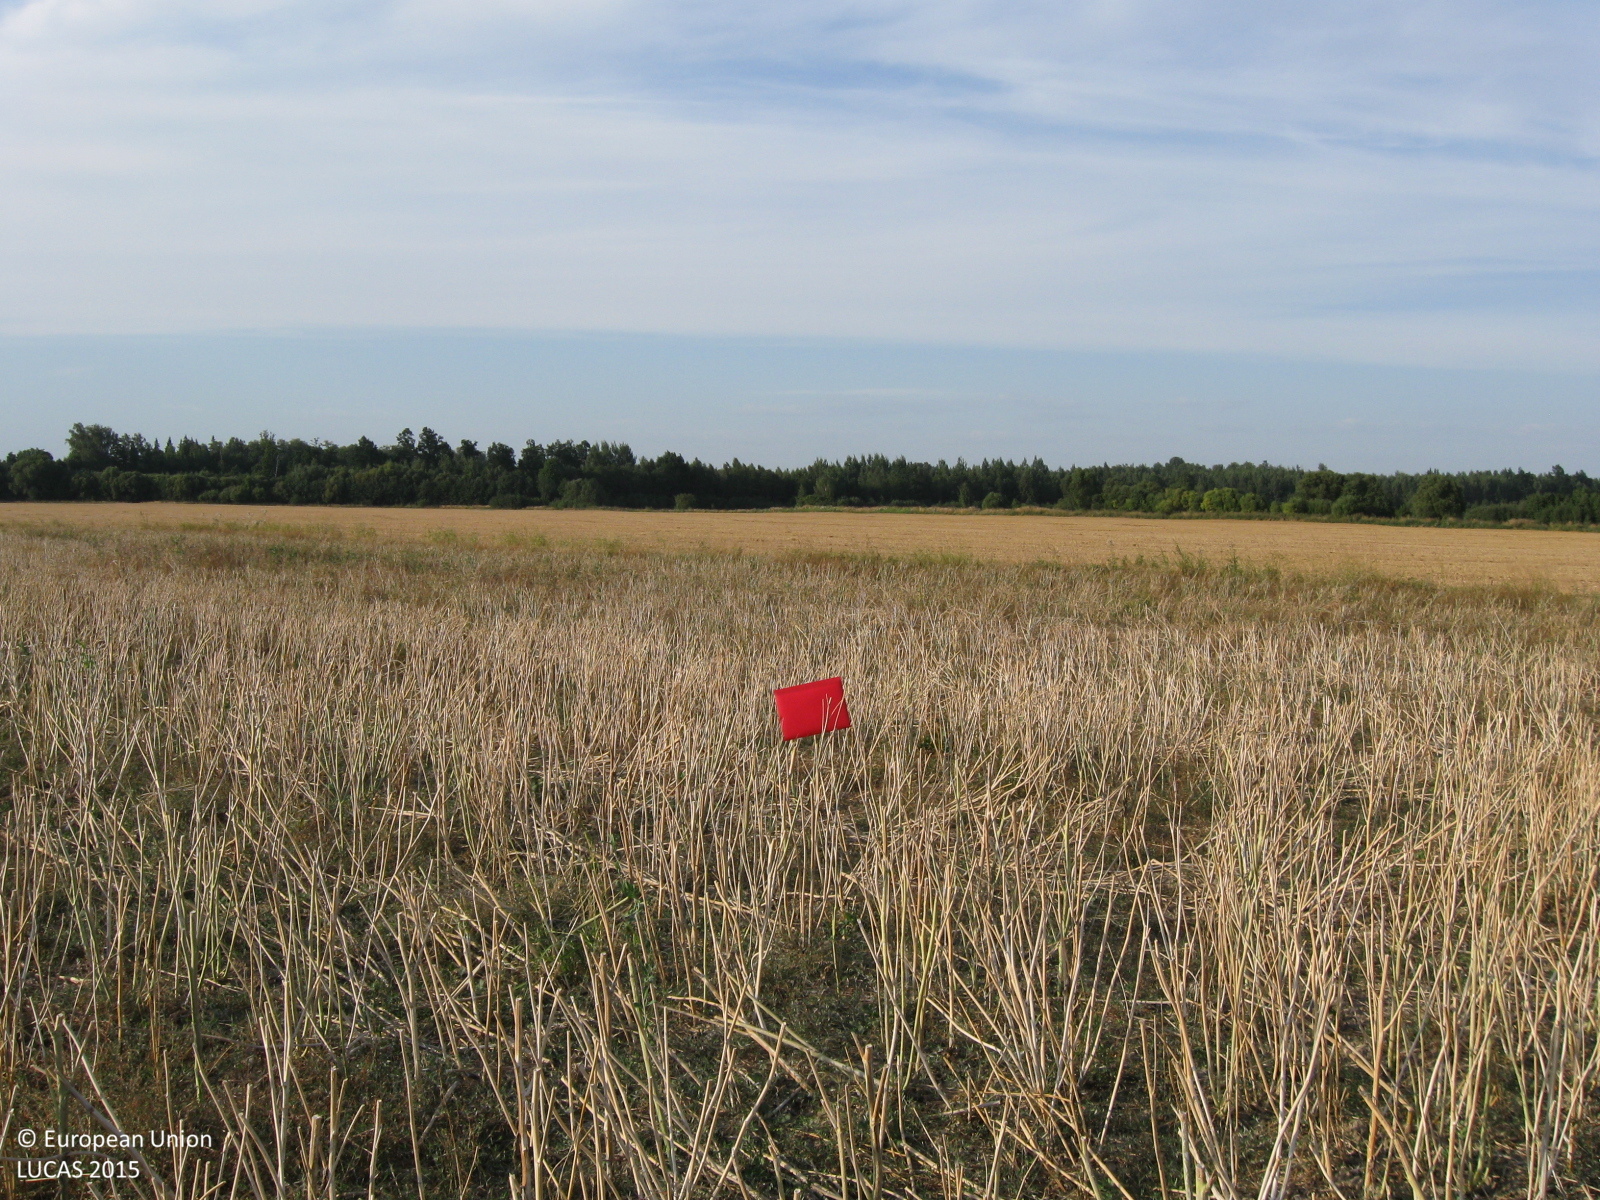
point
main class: Cropland
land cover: Rape and turnip rape
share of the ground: > 75 %
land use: Agriculture (excluding fallow land and kitchen gardens)
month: August
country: LT
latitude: 55.2812
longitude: 22.8674
